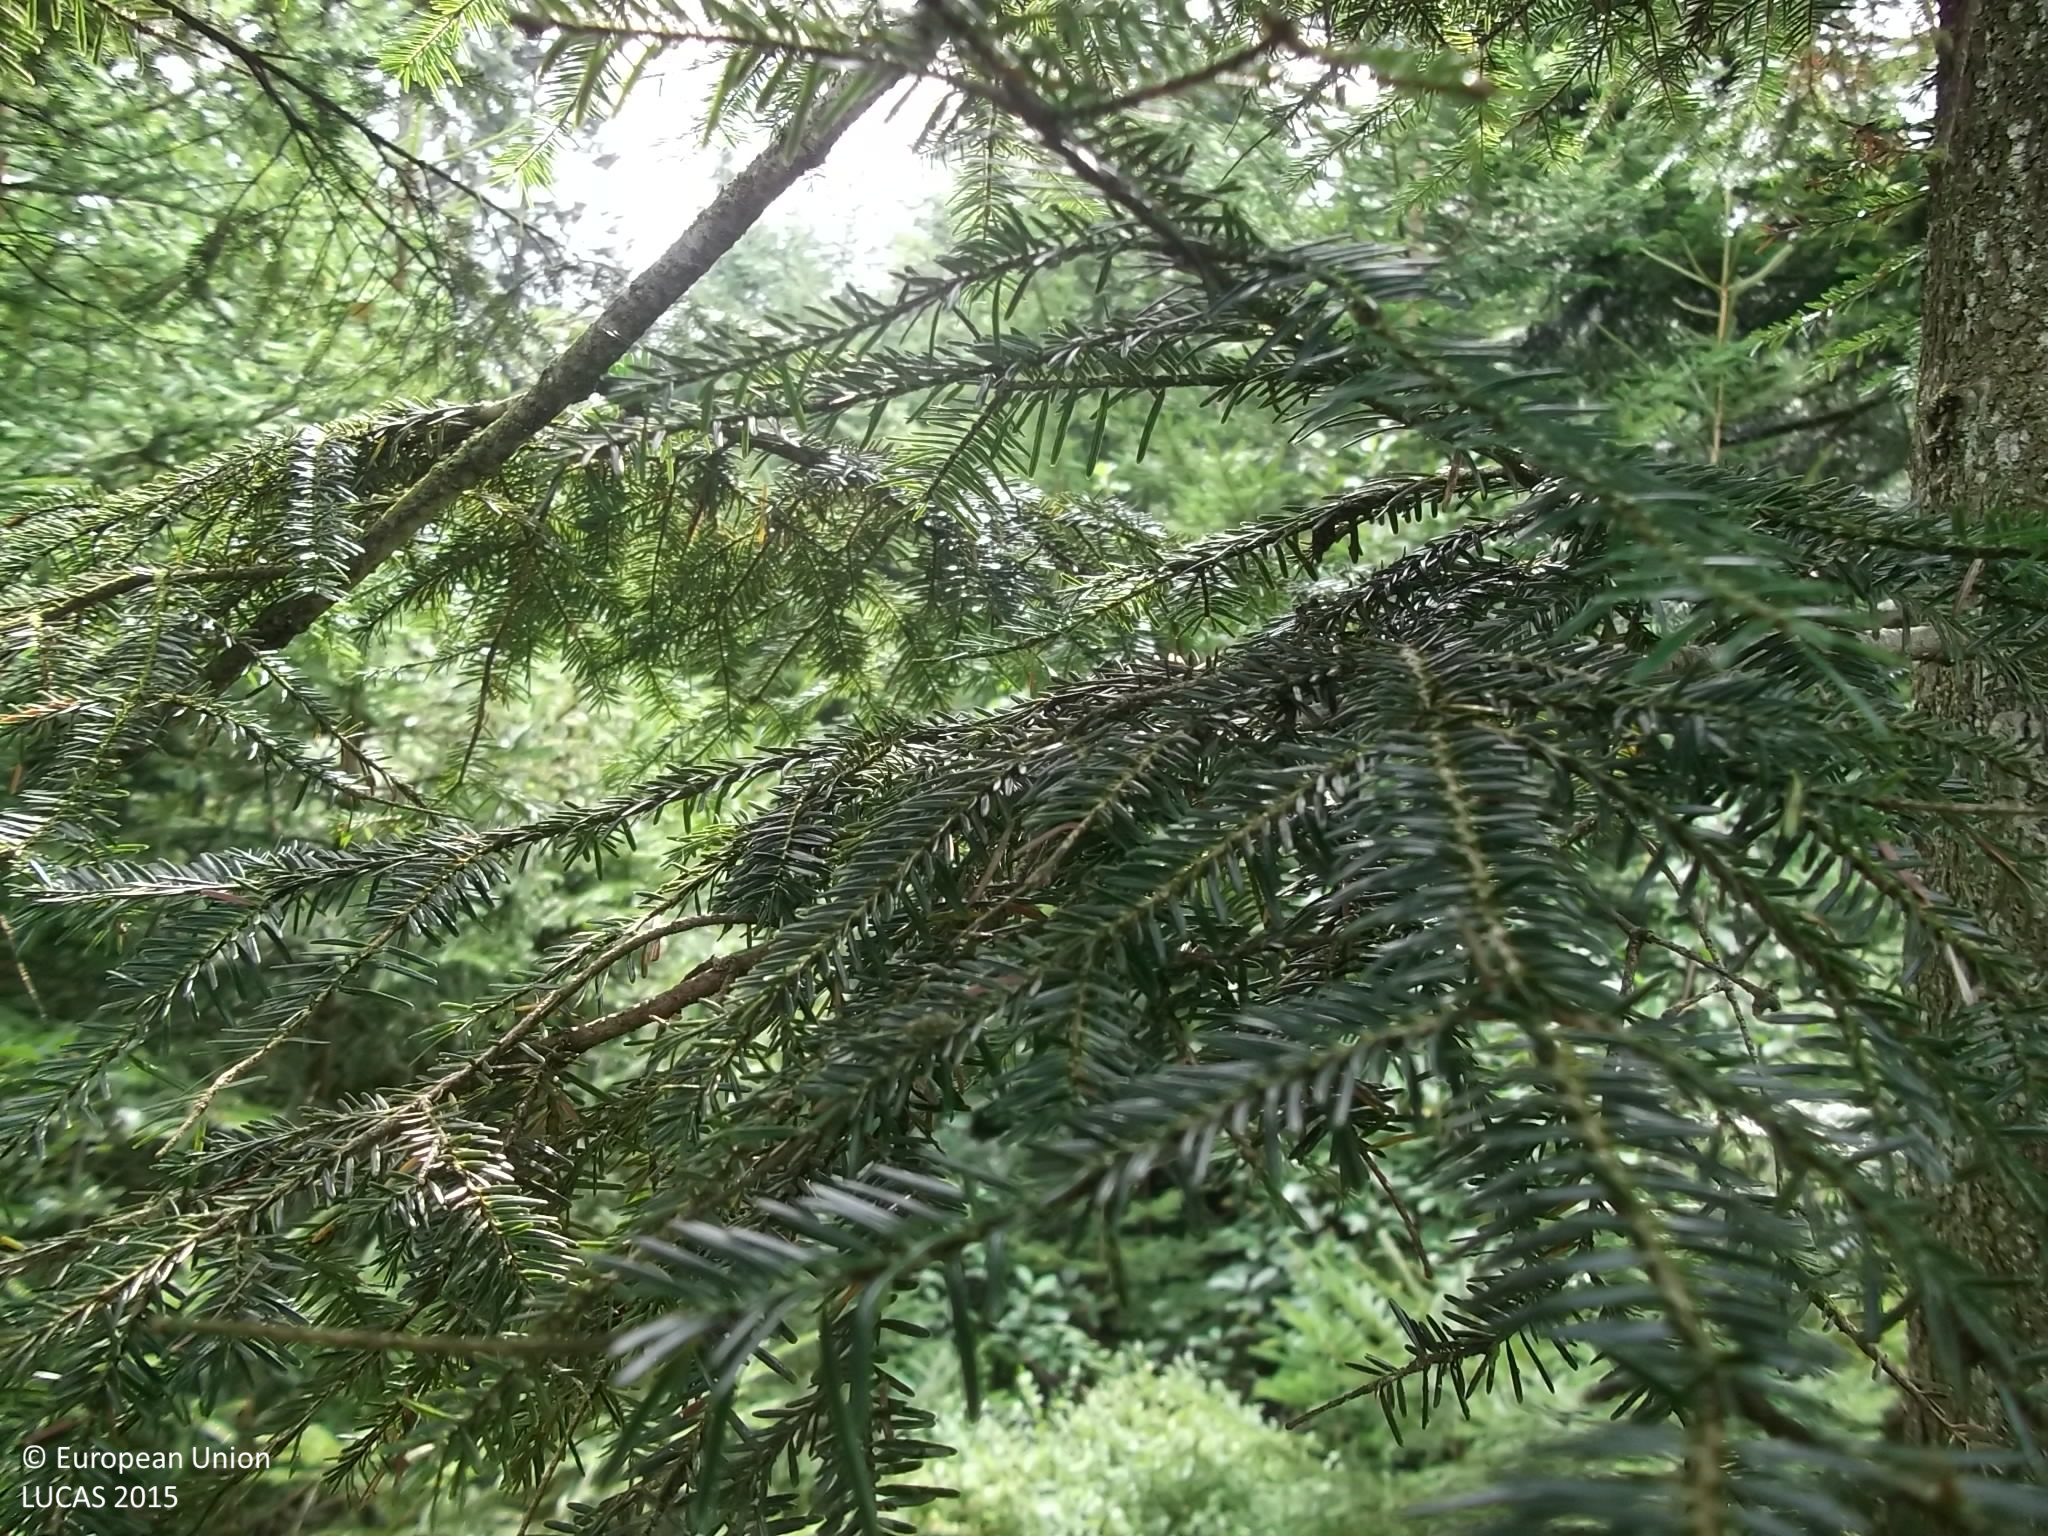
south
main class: Grassland
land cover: Grassland with sparse tree/shrub cover
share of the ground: > 75 %
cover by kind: herbaceous plants 90 %, coniferous forest trees 5 %, shrubs 5 %
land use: Forestry
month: August
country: AT
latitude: 47.9742
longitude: 13.3613
